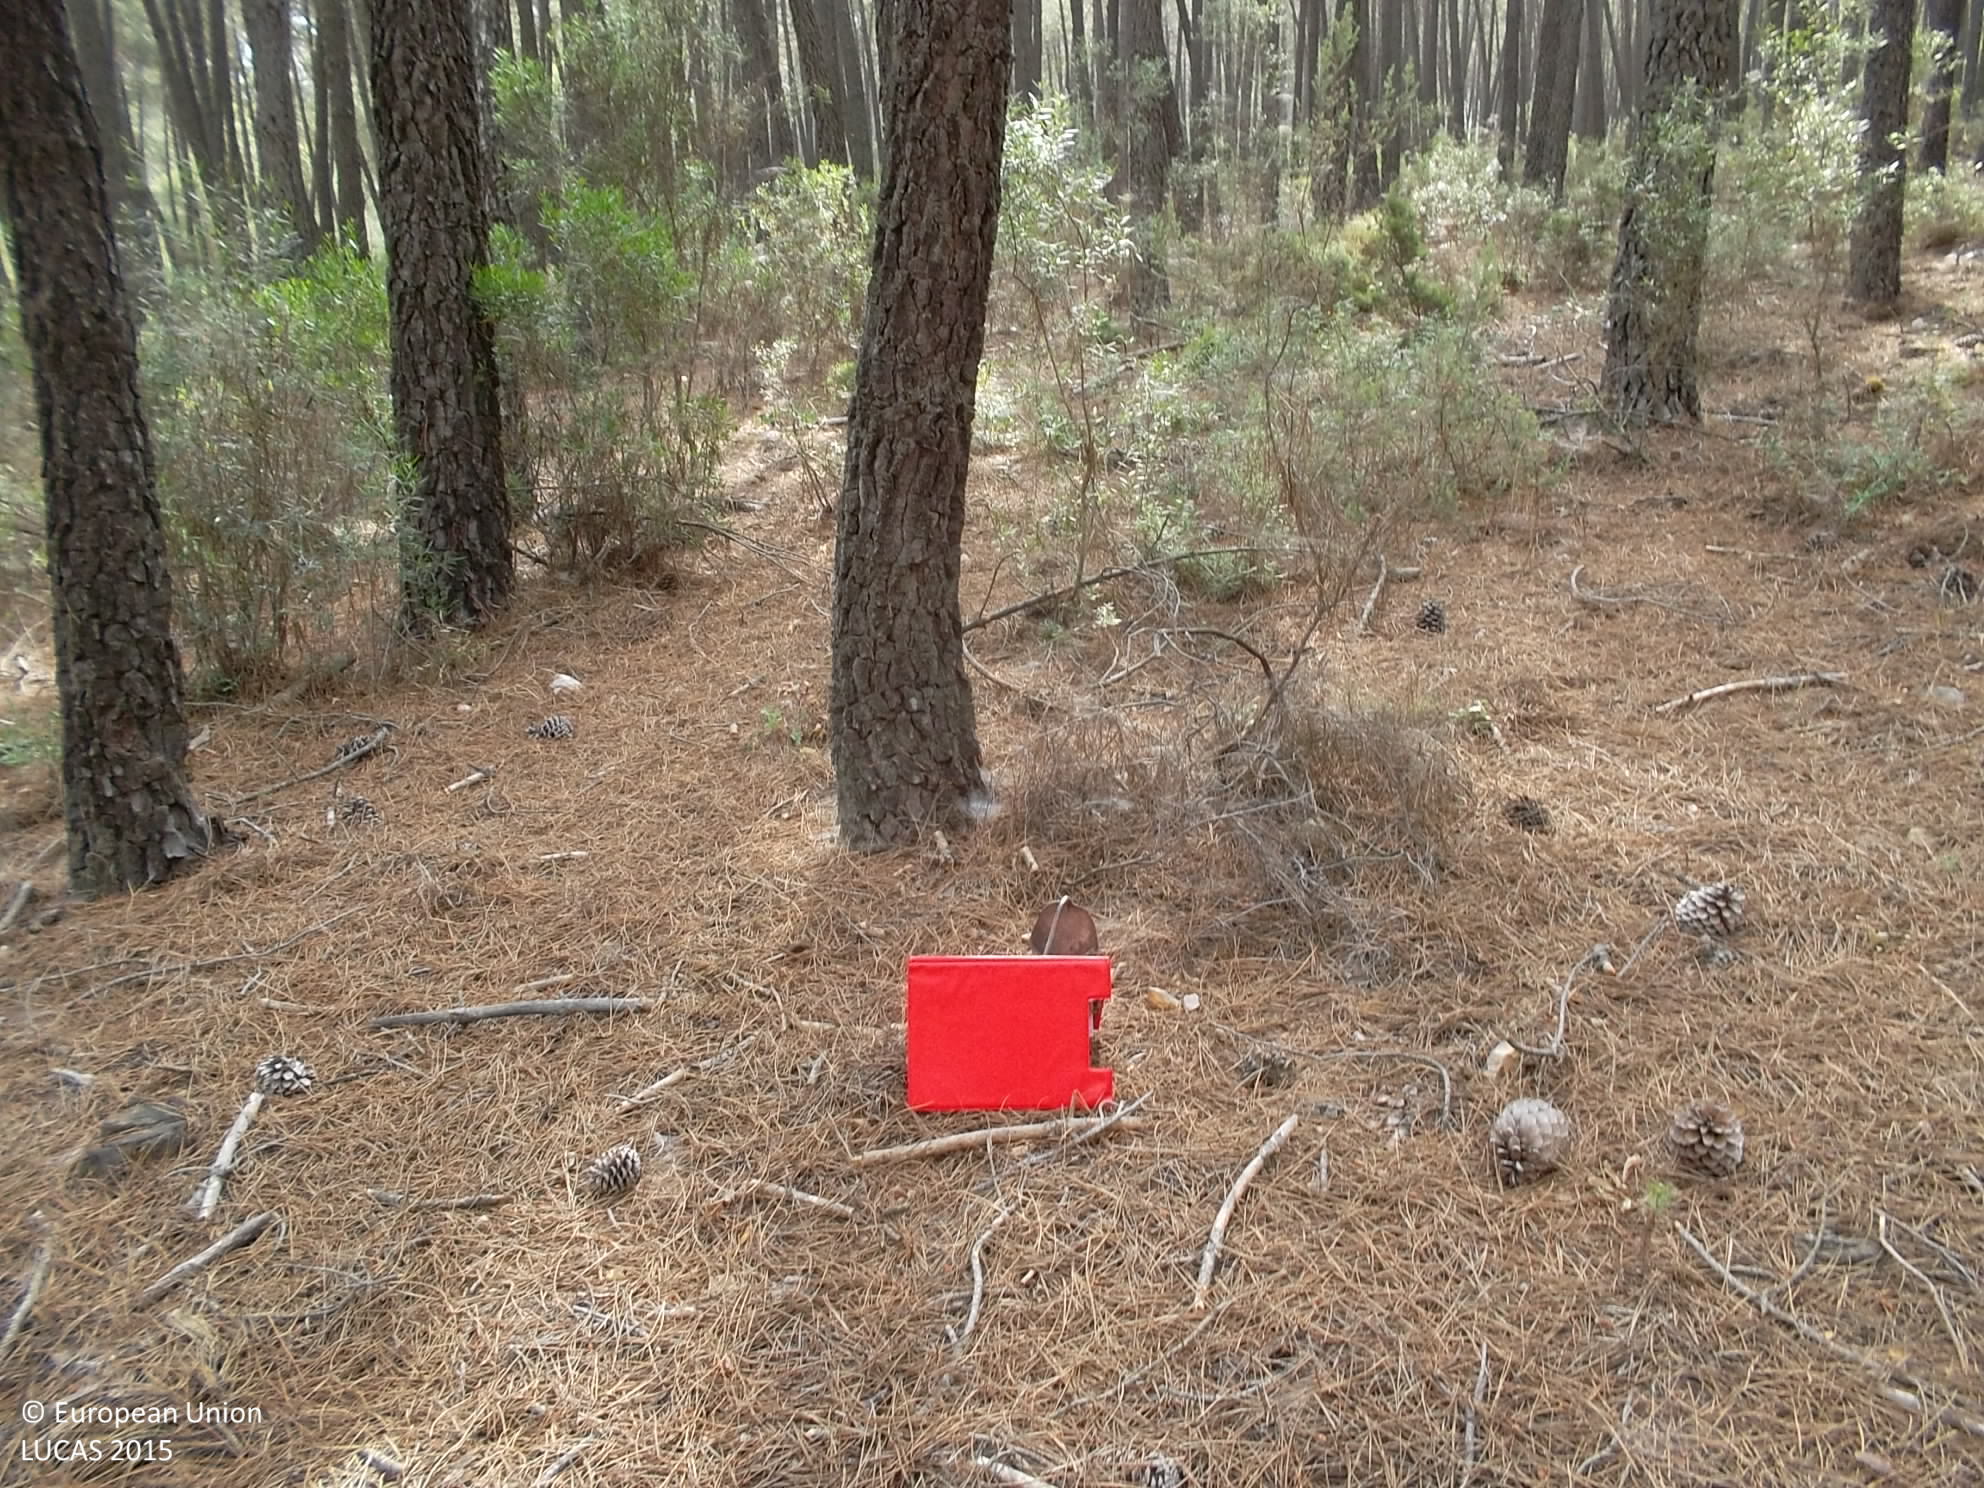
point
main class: Woodland
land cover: Pine dominated coniferous woodland
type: coniferous forest of the mediterranean region
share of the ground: > 75 %
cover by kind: coniferous forest trees 80 %, broadleaved forest trees 20 %
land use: Forestry
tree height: > 5 m
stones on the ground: 10 - 25 %
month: June
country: ES
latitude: 39.1721
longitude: -4.8166
